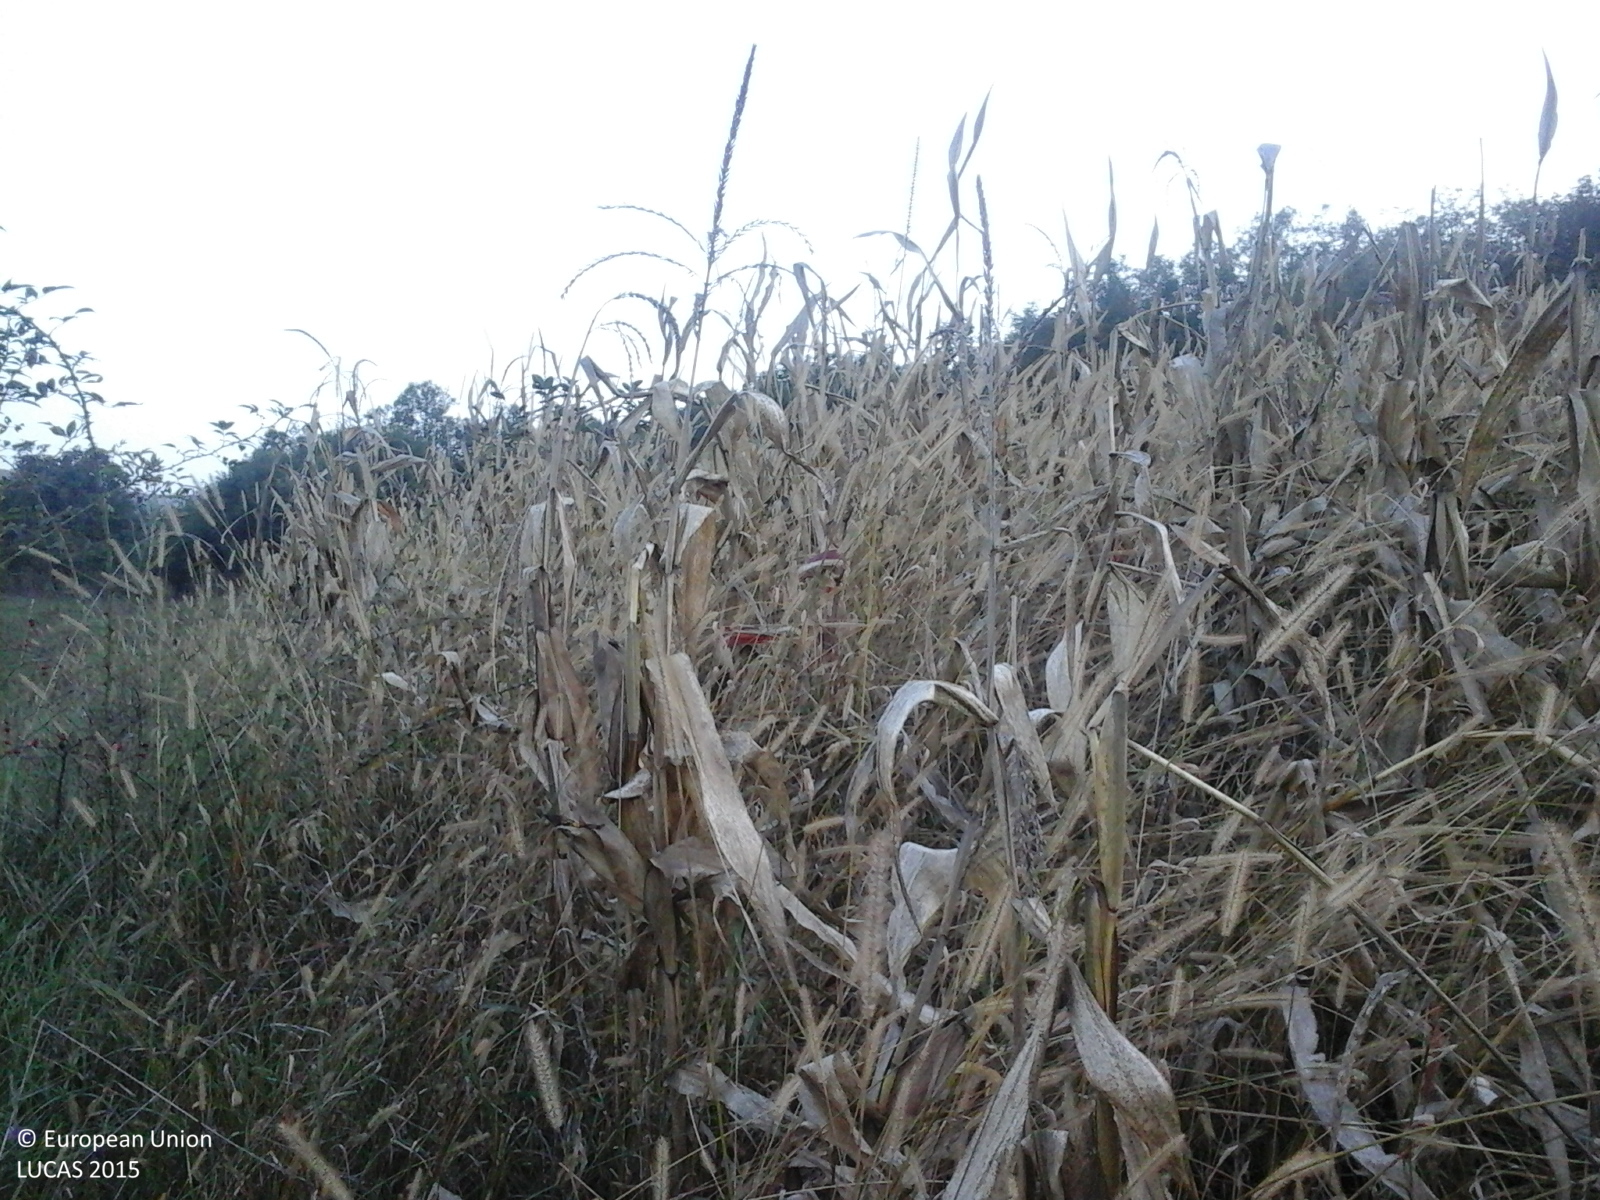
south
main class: Cropland
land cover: Maize
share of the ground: > 75 %
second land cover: Spontaneously vegetated surfaces
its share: > 75 %
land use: Agriculture (excluding fallow land and kitchen gardens)
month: October
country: RO
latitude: 46.3363
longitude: 24.0158
